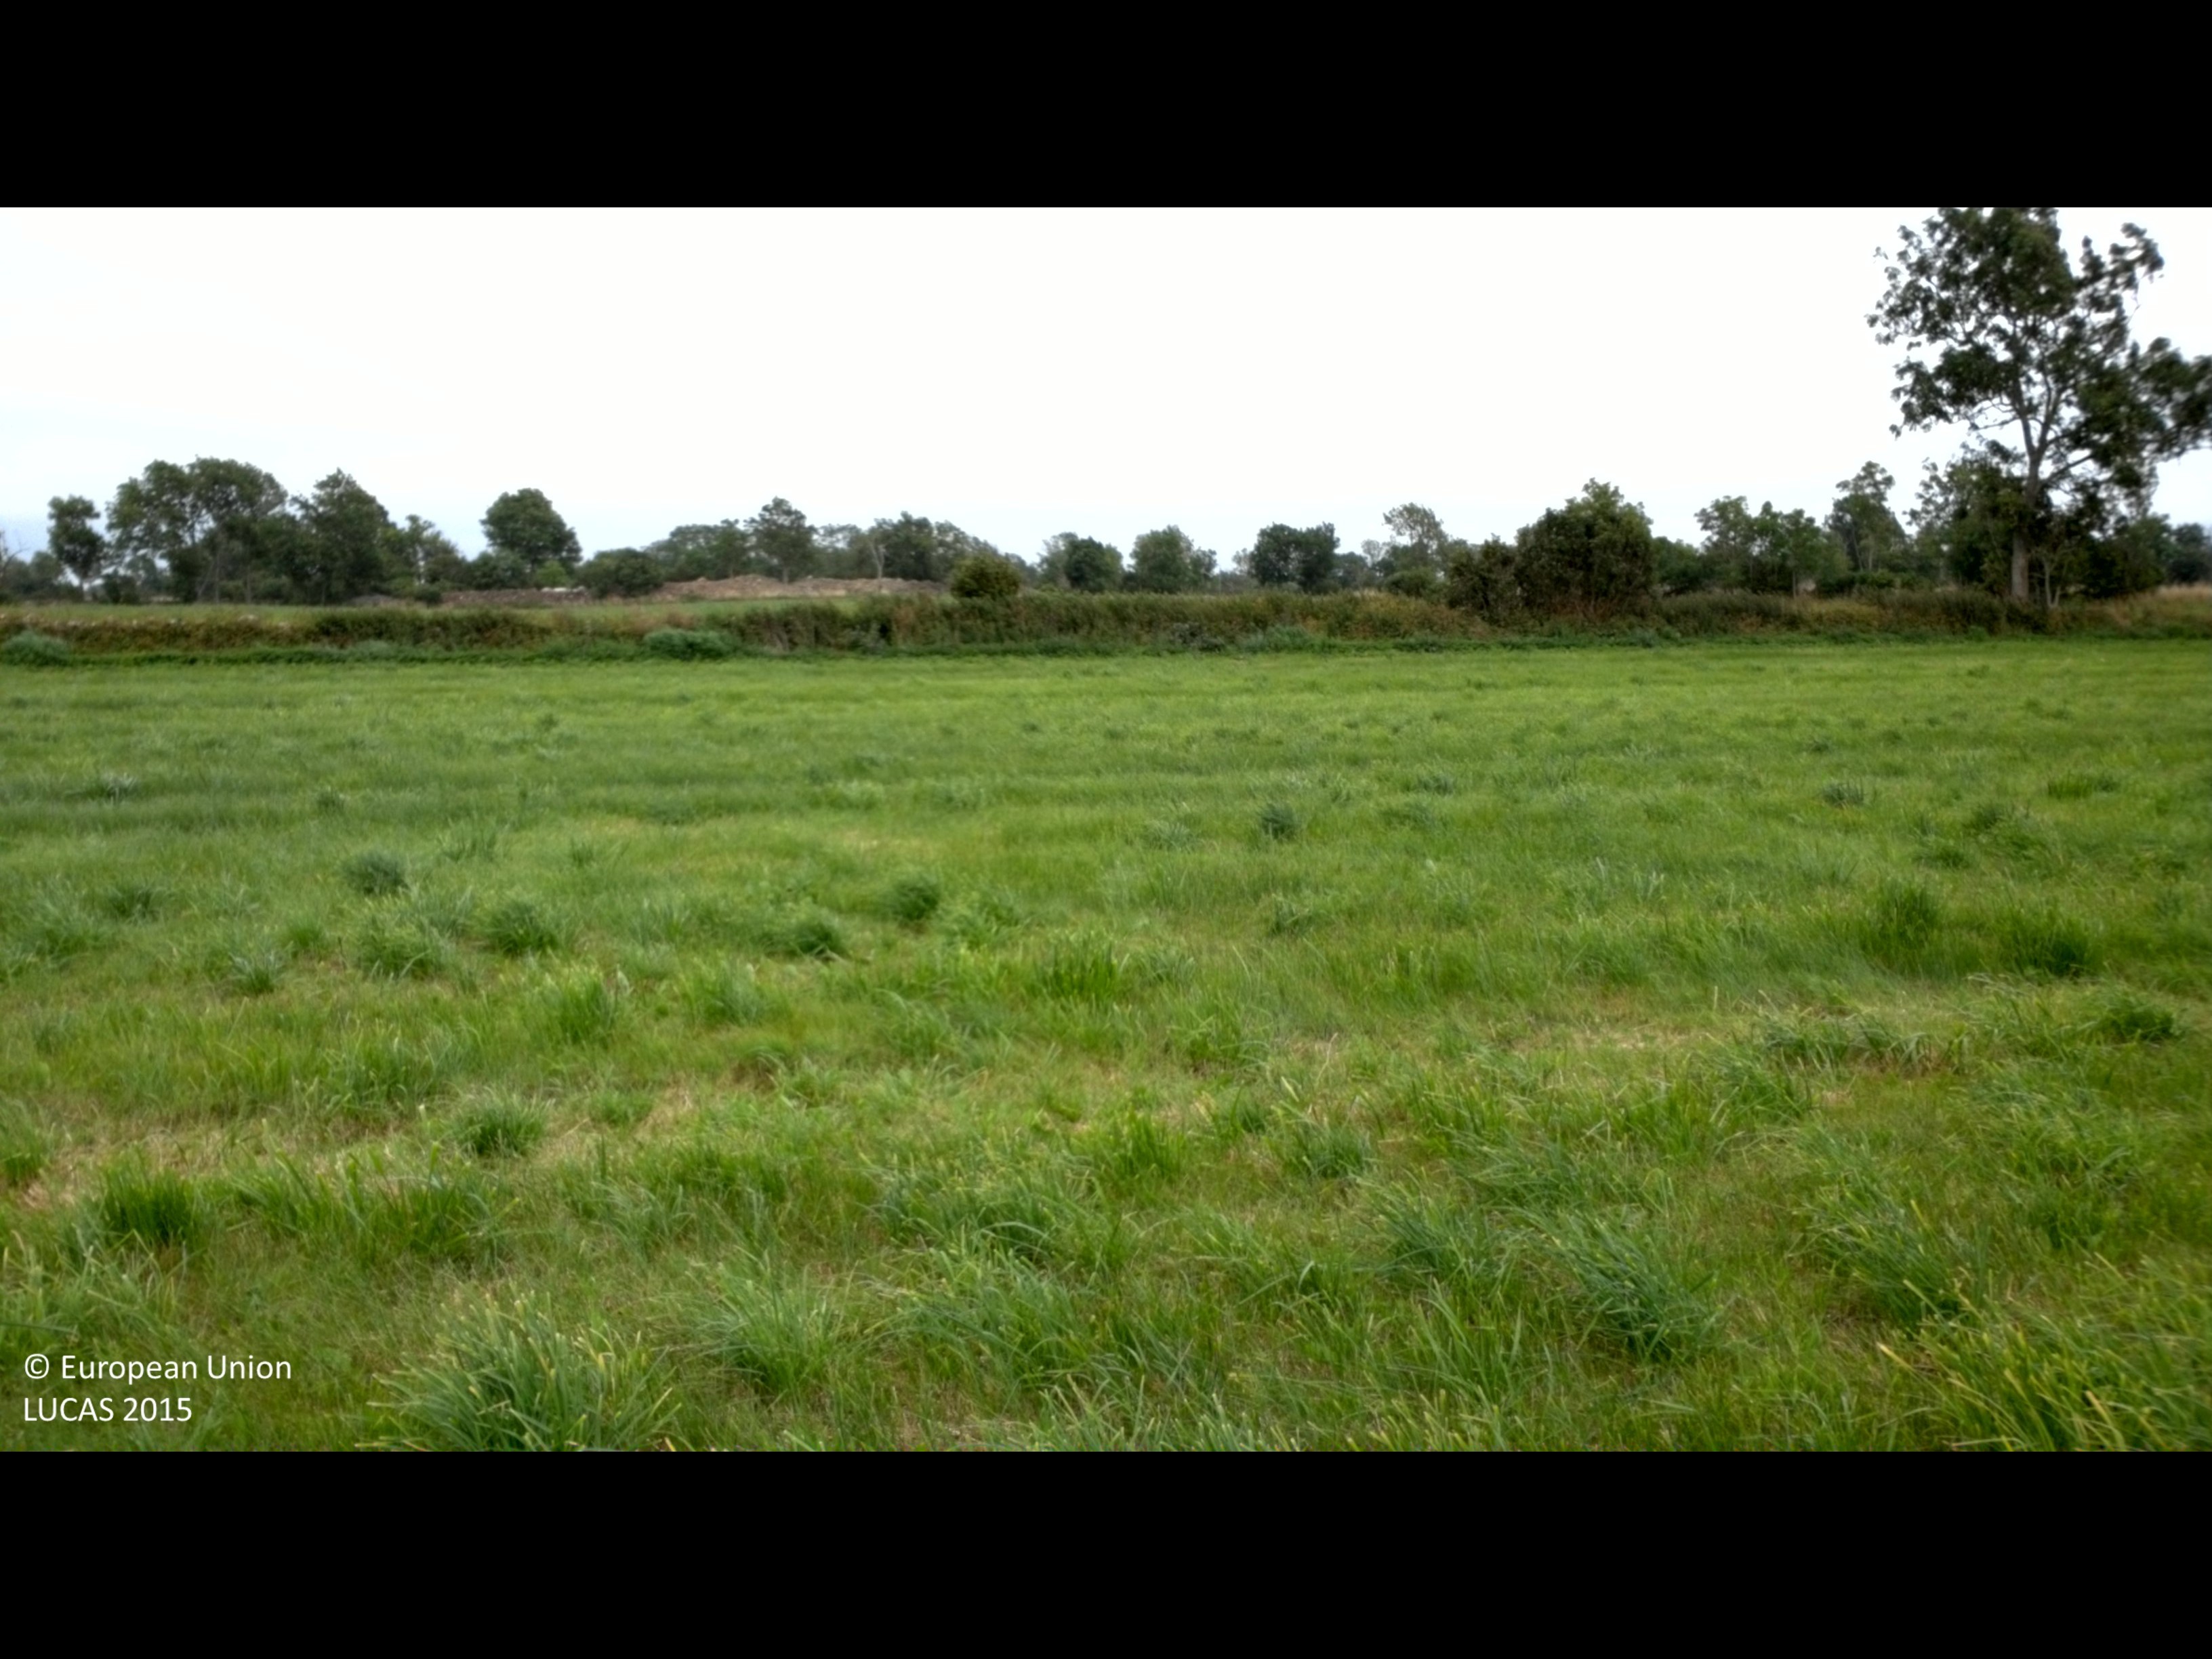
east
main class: Cropland
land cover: Temporary grasslands
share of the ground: > 75 %
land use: Agriculture (excluding fallow land and kitchen gardens)
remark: Harvested field
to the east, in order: Temporary grasslands; Shruby margins; Dry stone walls; Shruby margins; Temporary grasslands; Grass margins; Groves; Dry stone walls; Grass margins; Tracks; Grassland without tree/shrub cover
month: July
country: SE
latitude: 56.8101
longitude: 16.6351
